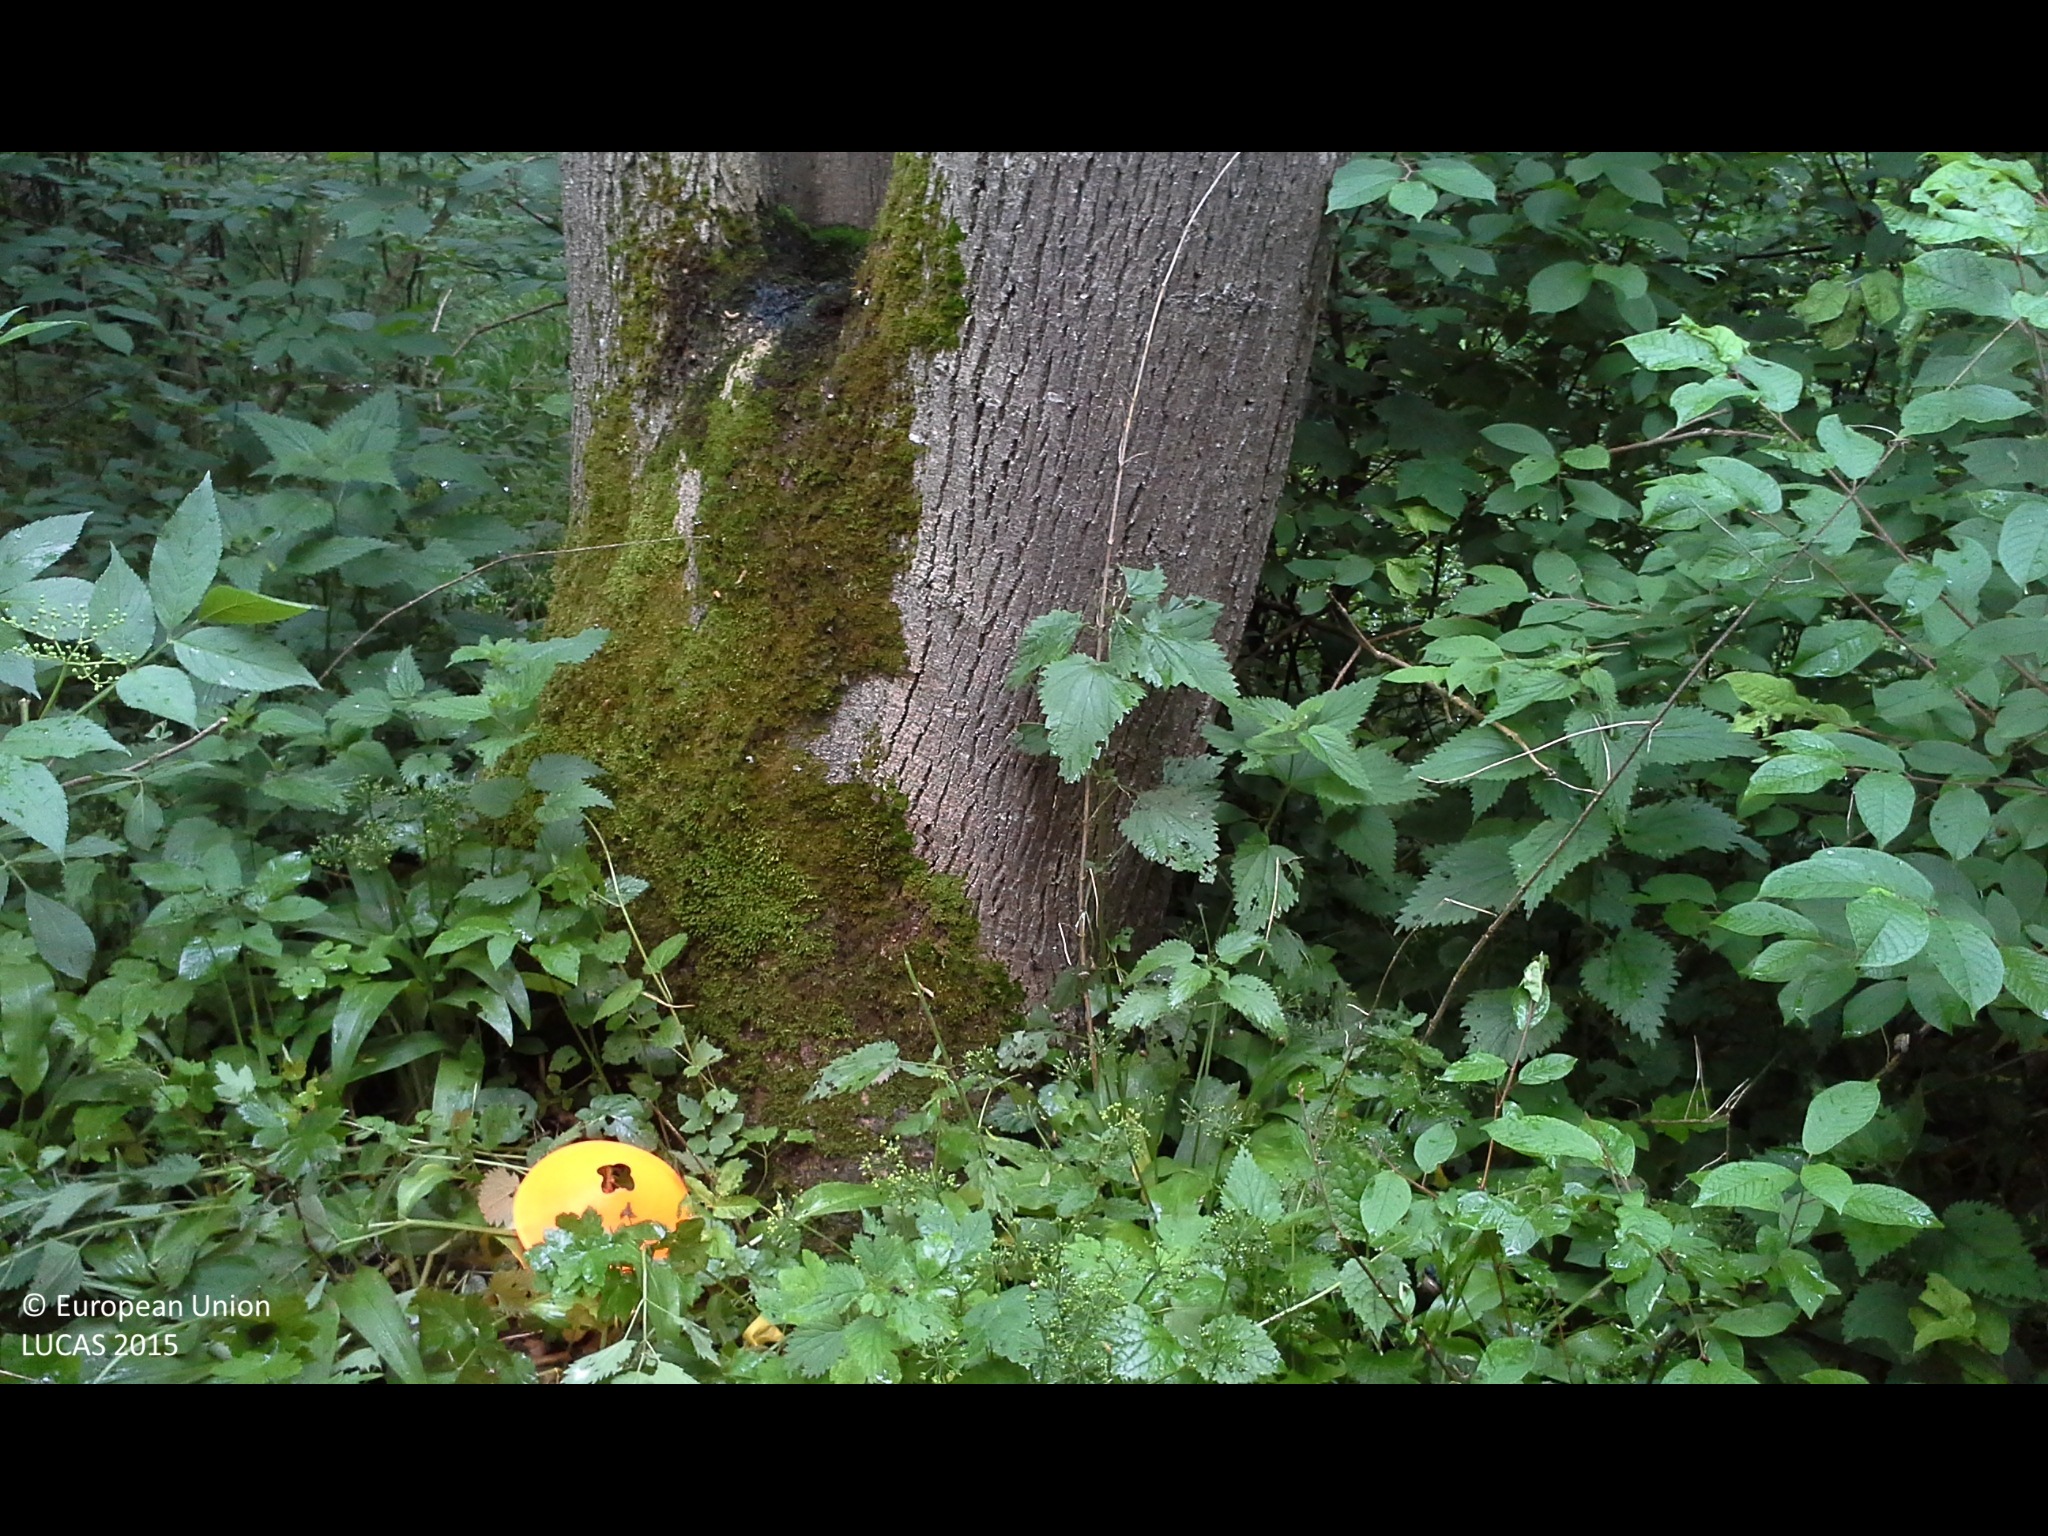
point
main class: Woodland
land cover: Broadleaved woodland
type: floodplain forest
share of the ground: > 75 %
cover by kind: broadleaved forest trees 80 %, shrubs 20 %
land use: Forestry
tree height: > 5 m
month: May
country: AT
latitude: 48.1602
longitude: 14.2348
